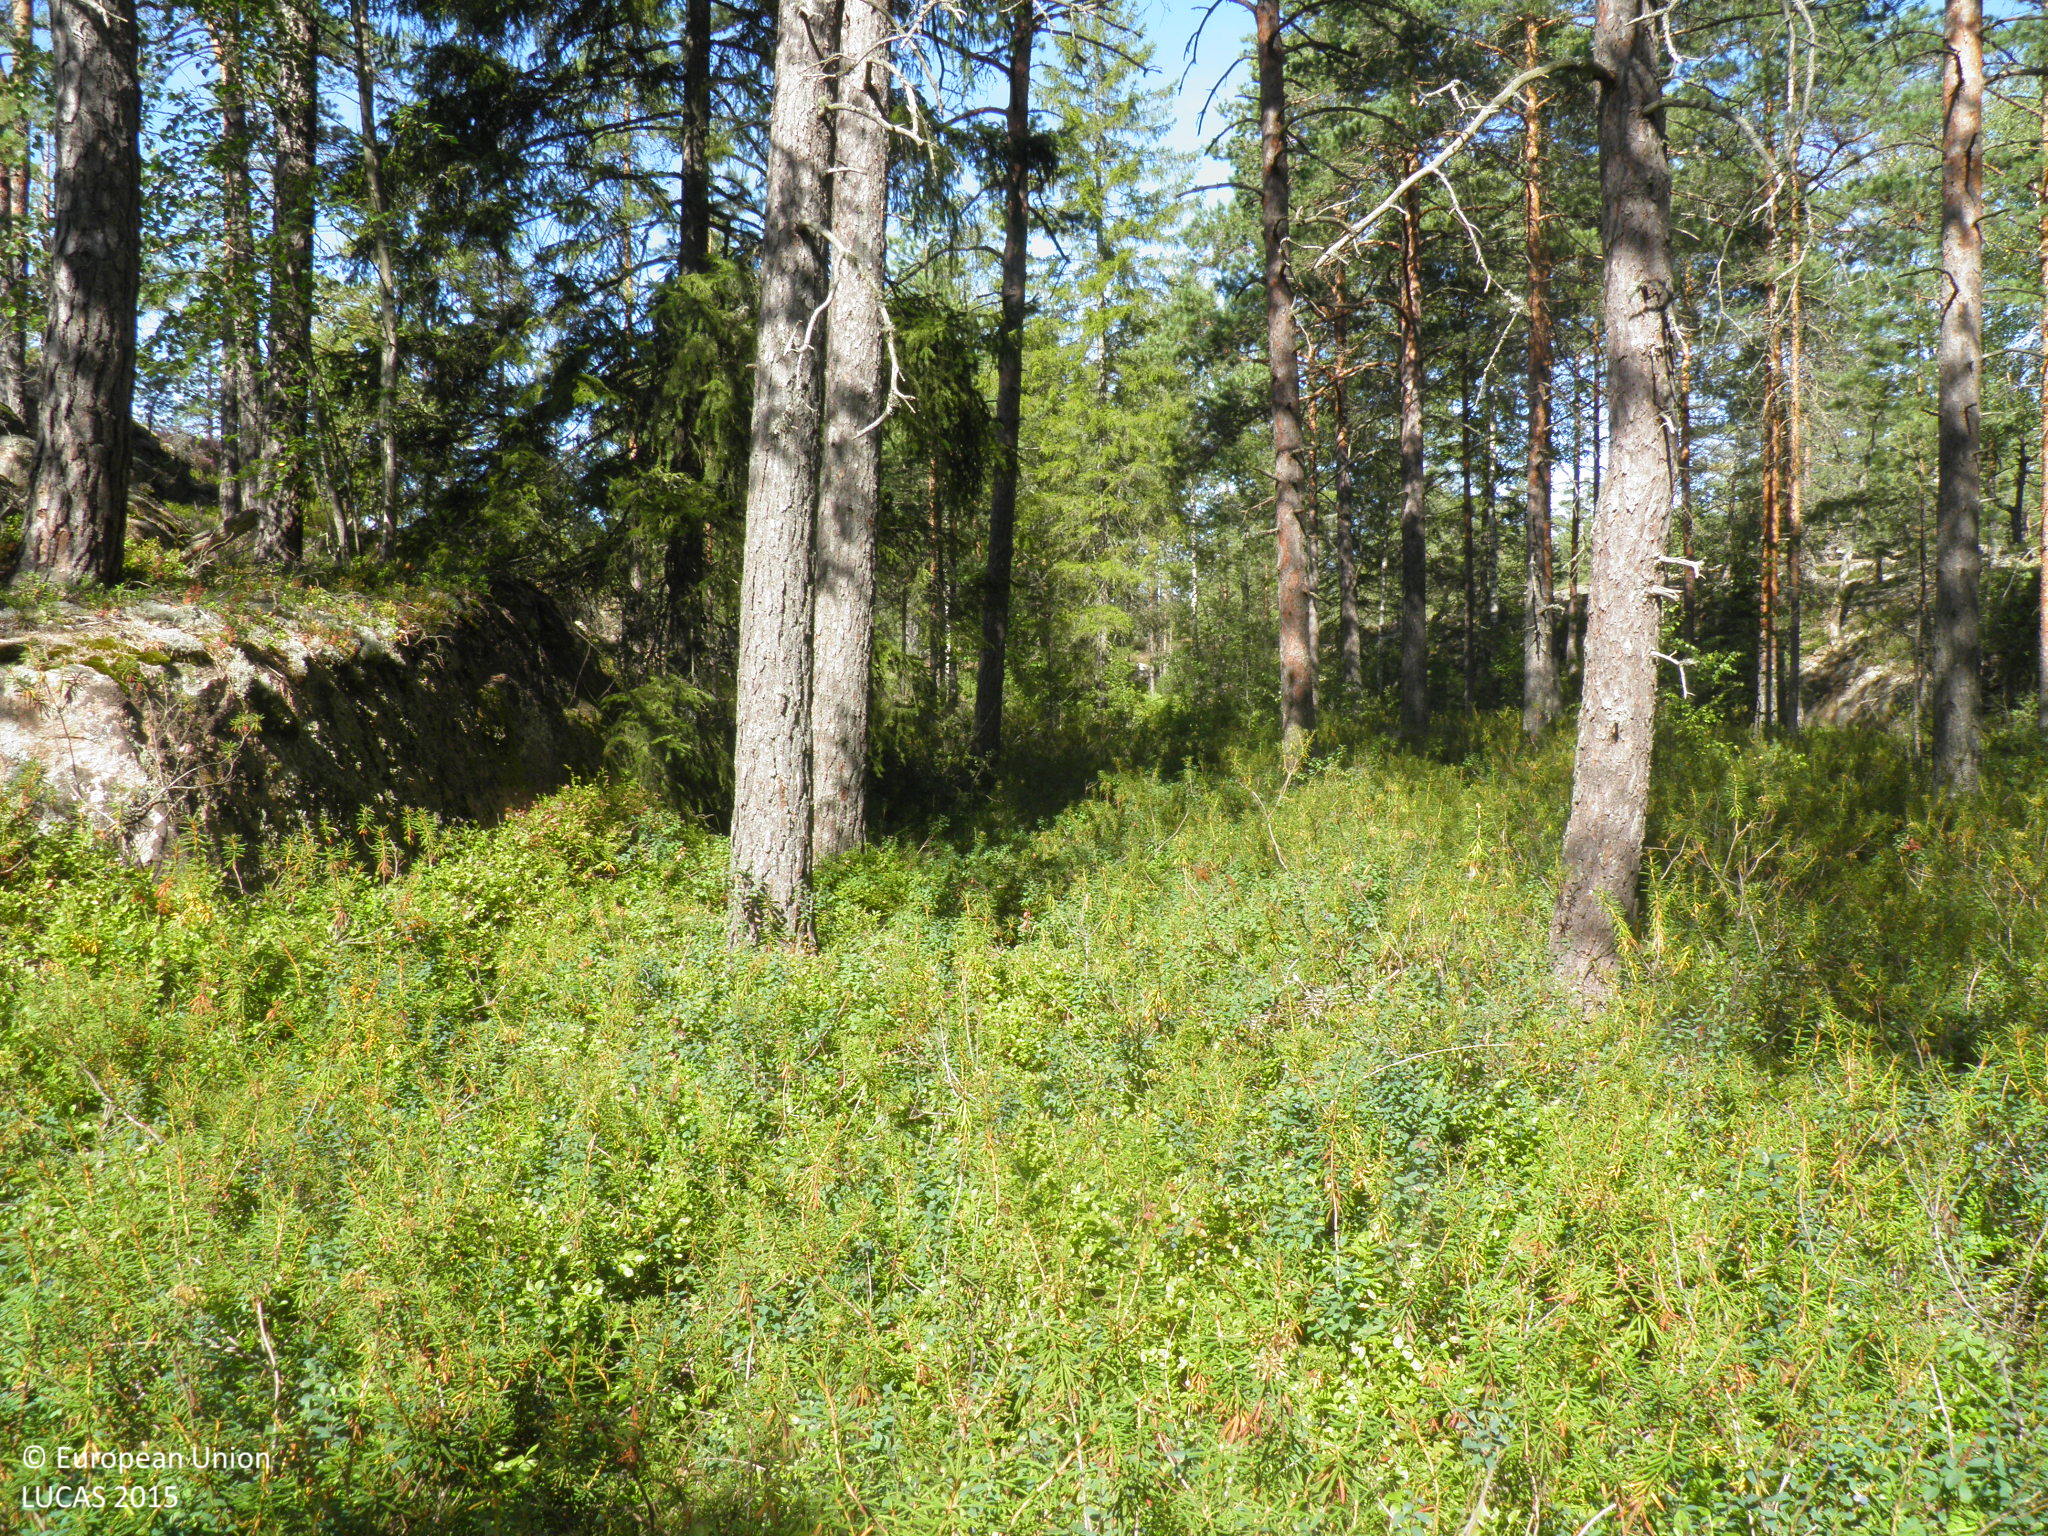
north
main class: Woodland
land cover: Pine dominated coniferous woodland
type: hemiboreal forest and nemoral coniferous forest and mixed broadleaved-coniferous forest
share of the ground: 50 - 75 %
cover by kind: coniferous forest trees 50 %, shrubs 30 %, lichens and mosses 10 %, consolidated bare surface 10 %
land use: Semi-natural and natural areas not in use
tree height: > 5 m
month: August
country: FI
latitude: 60.2077
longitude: 22.6873
